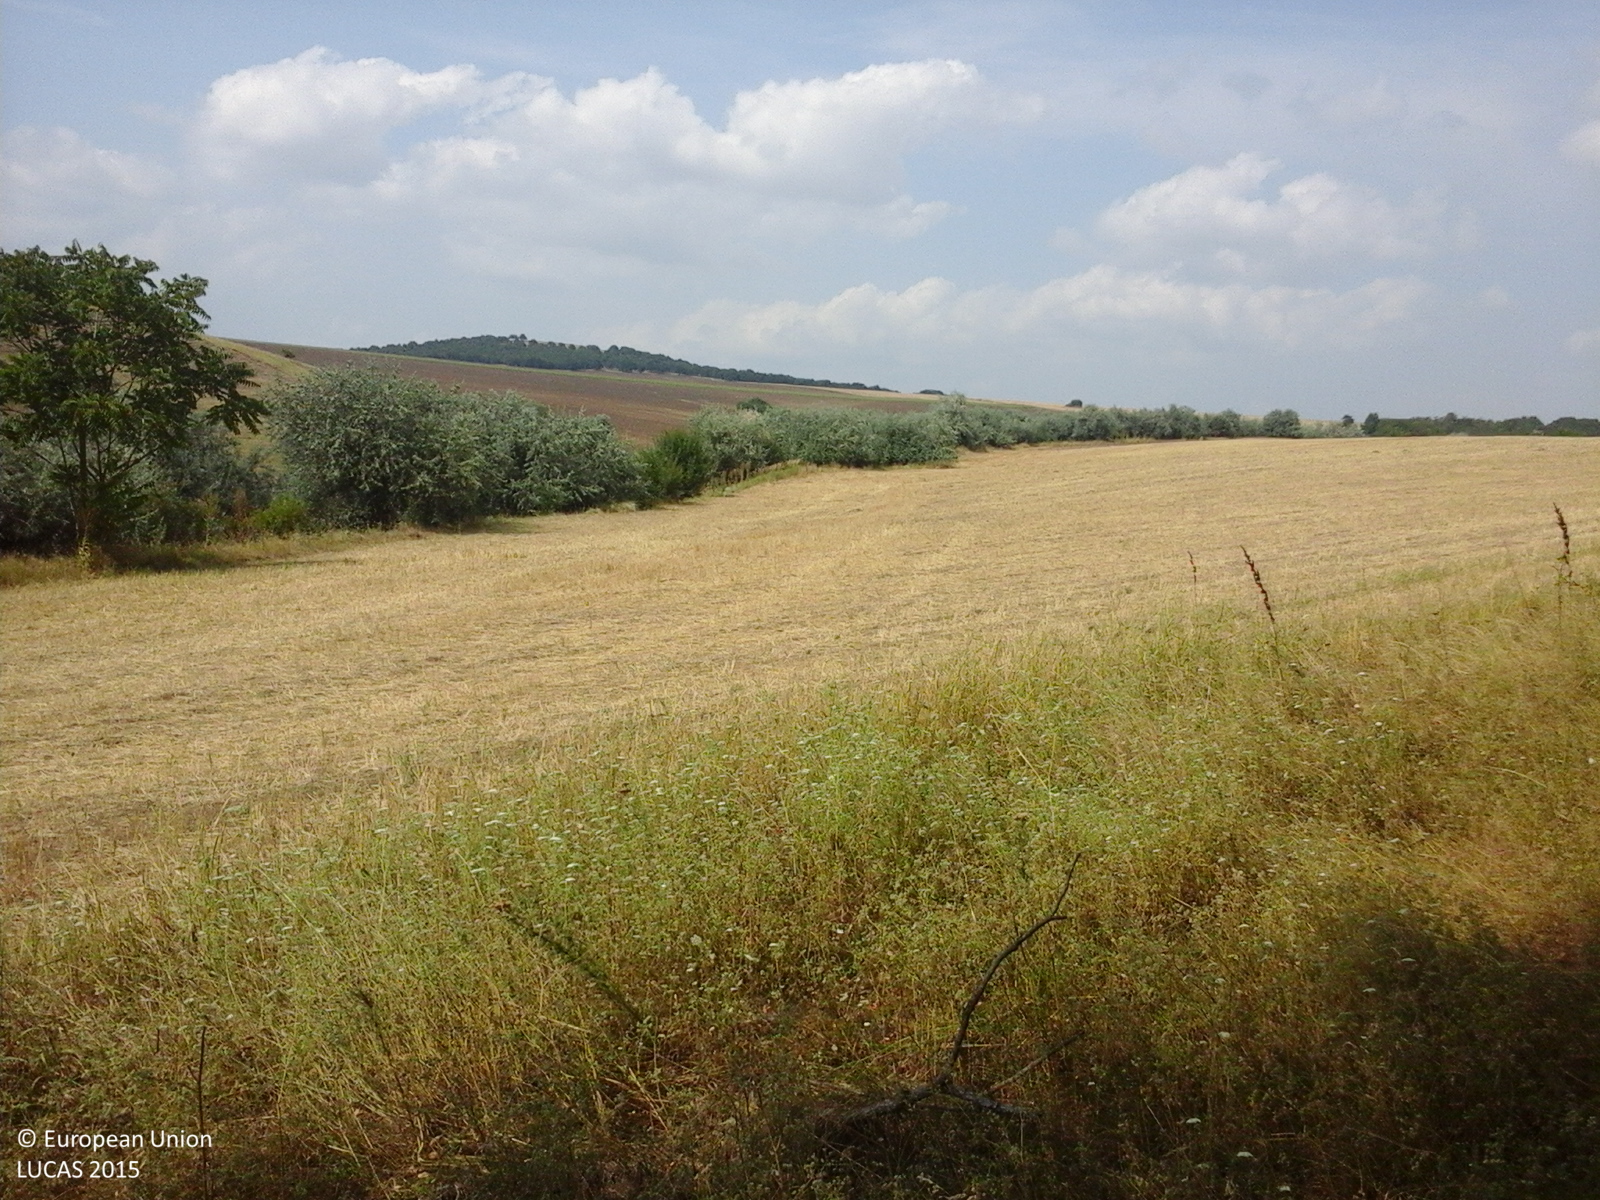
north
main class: Woodland
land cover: Broadleaved woodland
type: mesophytic deciduous forest
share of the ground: > 75 %
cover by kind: broadleaved forest trees 85 %, herbaceous plants 15 %
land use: Forestry
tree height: > 5 m
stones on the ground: 10 - 25 %
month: July
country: RO
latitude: 44.9816
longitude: 28.3737
